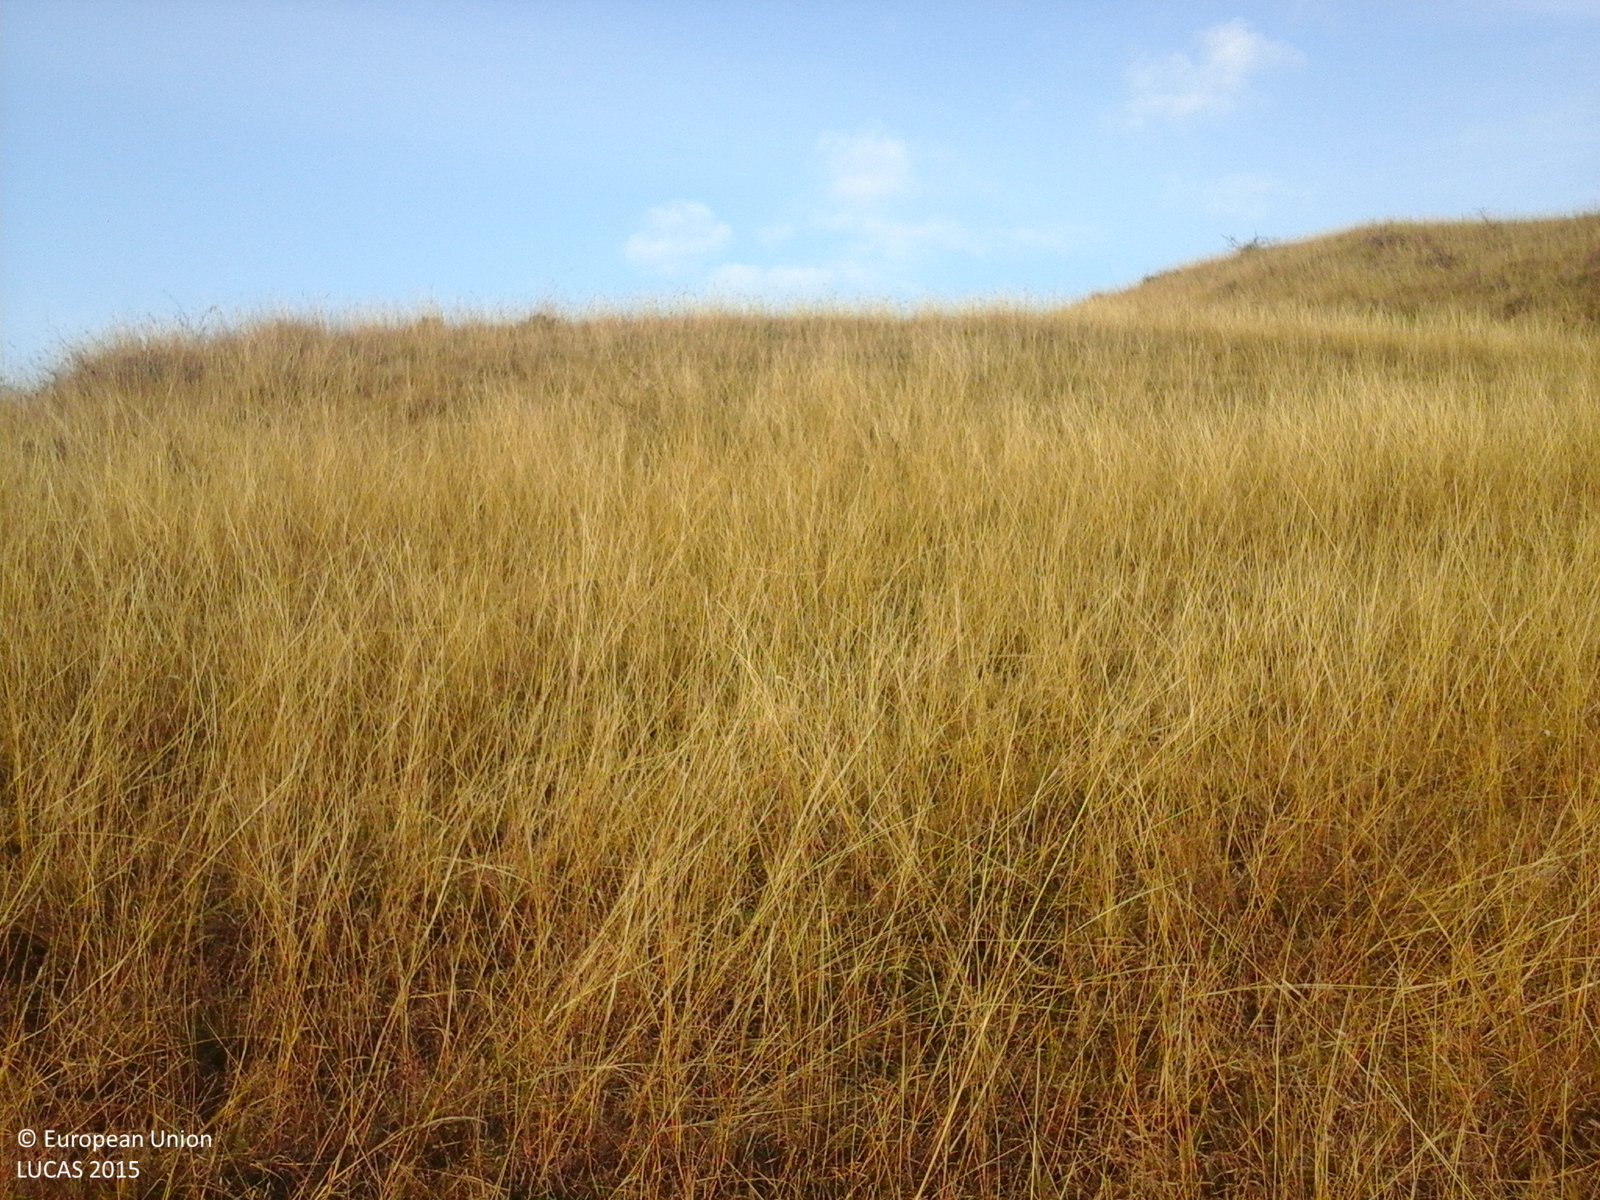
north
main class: Grassland
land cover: Grassland without tree/shrub cover
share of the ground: > 75 %
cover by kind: herbaceous plants 100 %
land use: Agriculture (excluding fallow land and kitchen gardens)
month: October
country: RO
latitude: 45.4319
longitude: 26.5777
